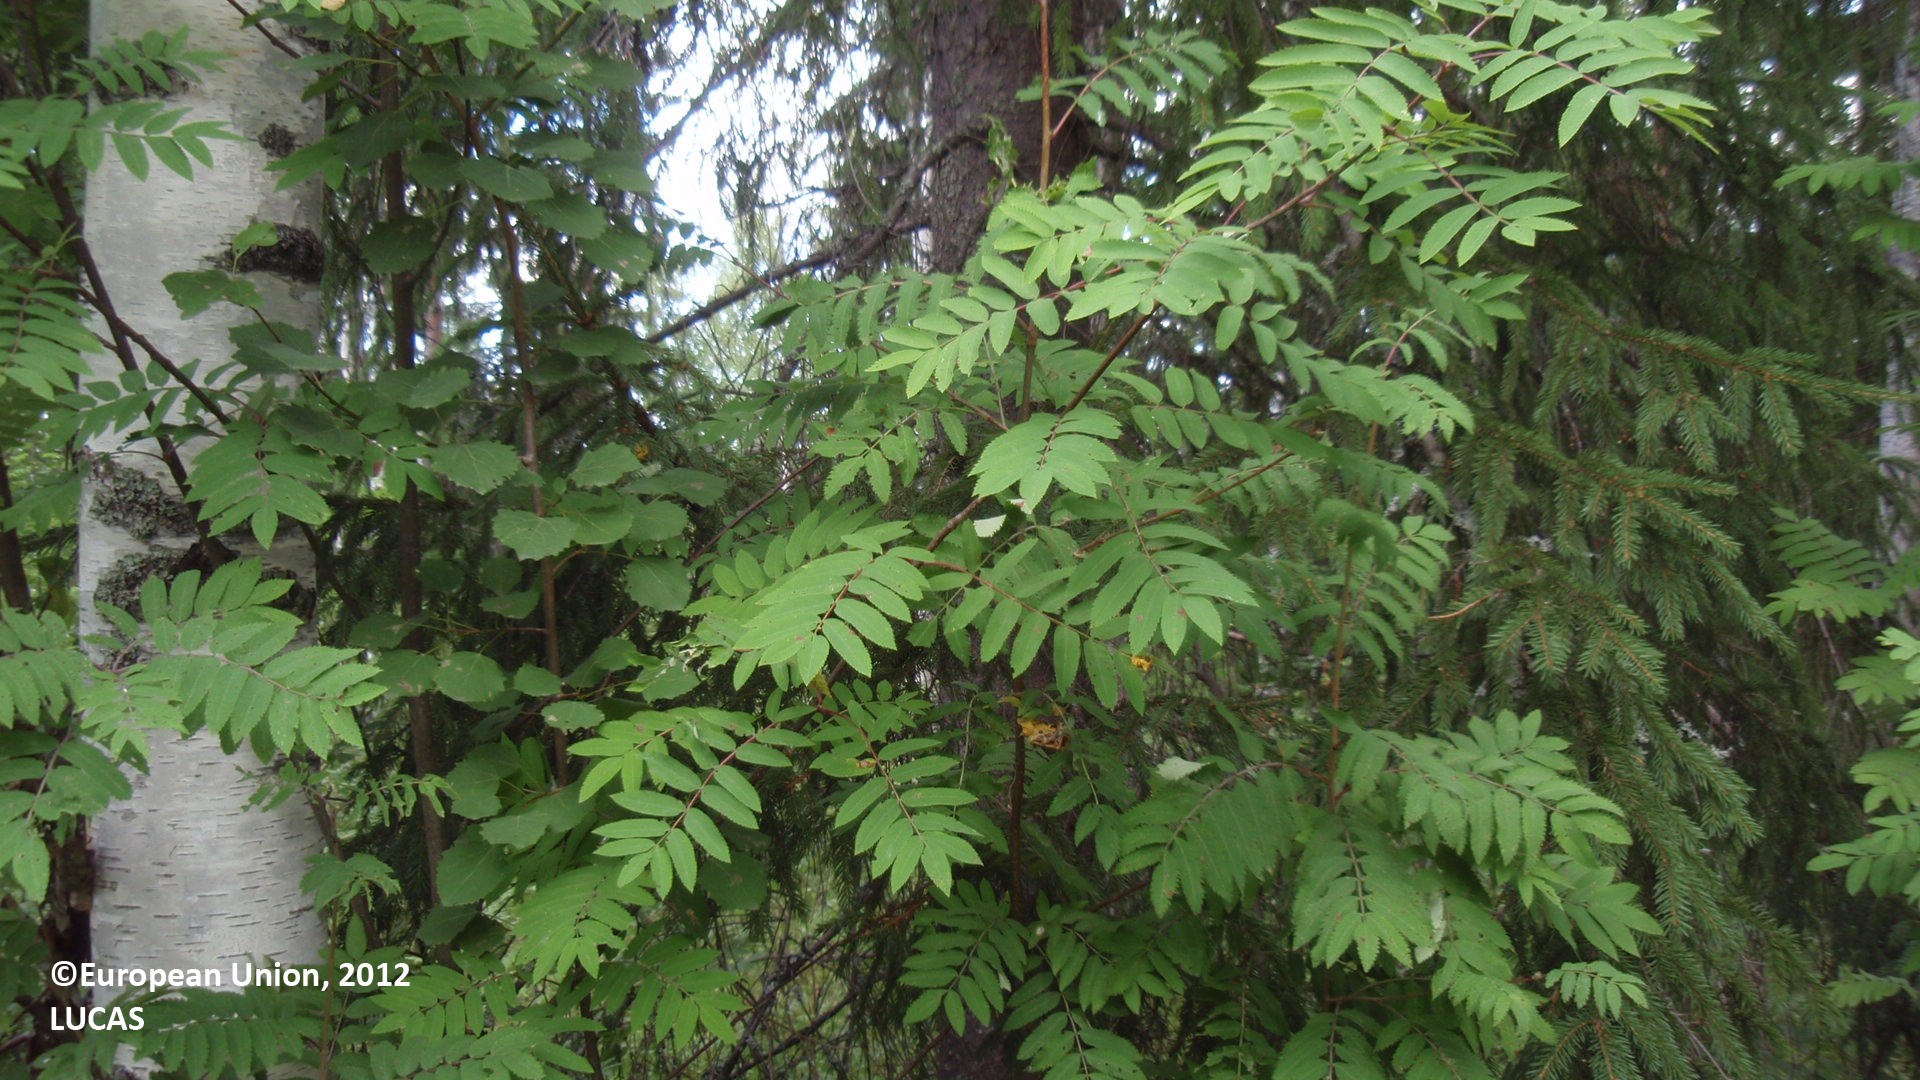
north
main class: Woodland
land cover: Spruce dominated mixed woodland
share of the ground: 50 - 75 %
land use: Forestry
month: July
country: FI
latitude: 61.3796
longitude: 28.8858
